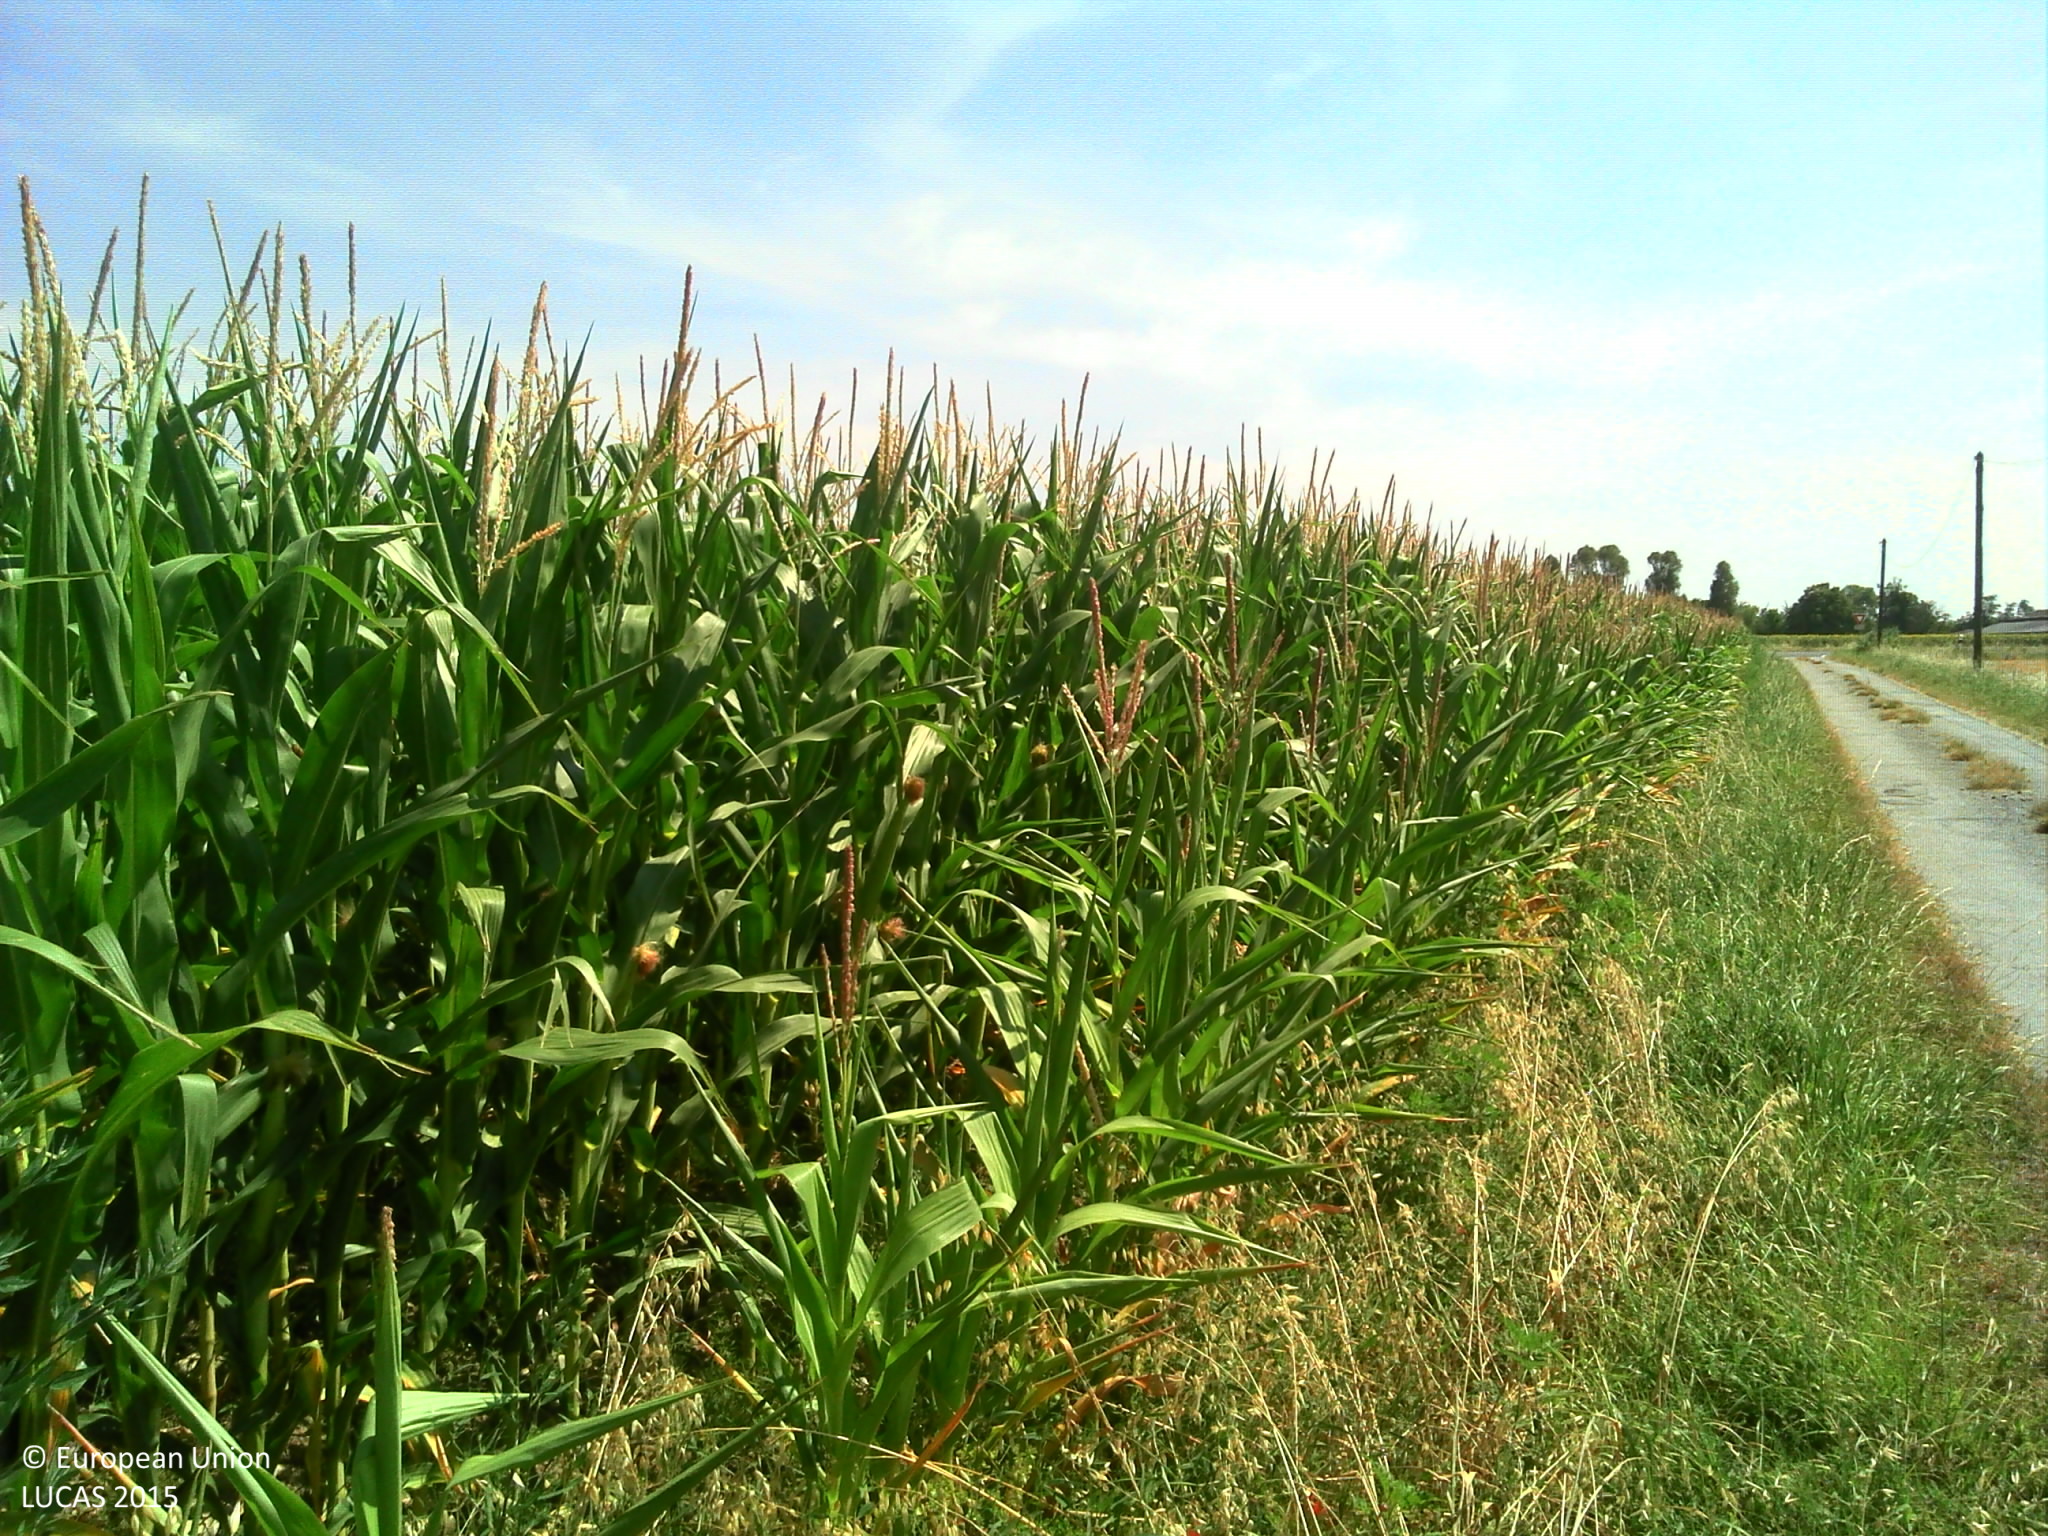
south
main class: Cropland
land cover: Maize
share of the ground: > 75 %
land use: Agriculture (excluding fallow land and kitchen gardens)
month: July
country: FR
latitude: 44.9729
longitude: 5.0479
